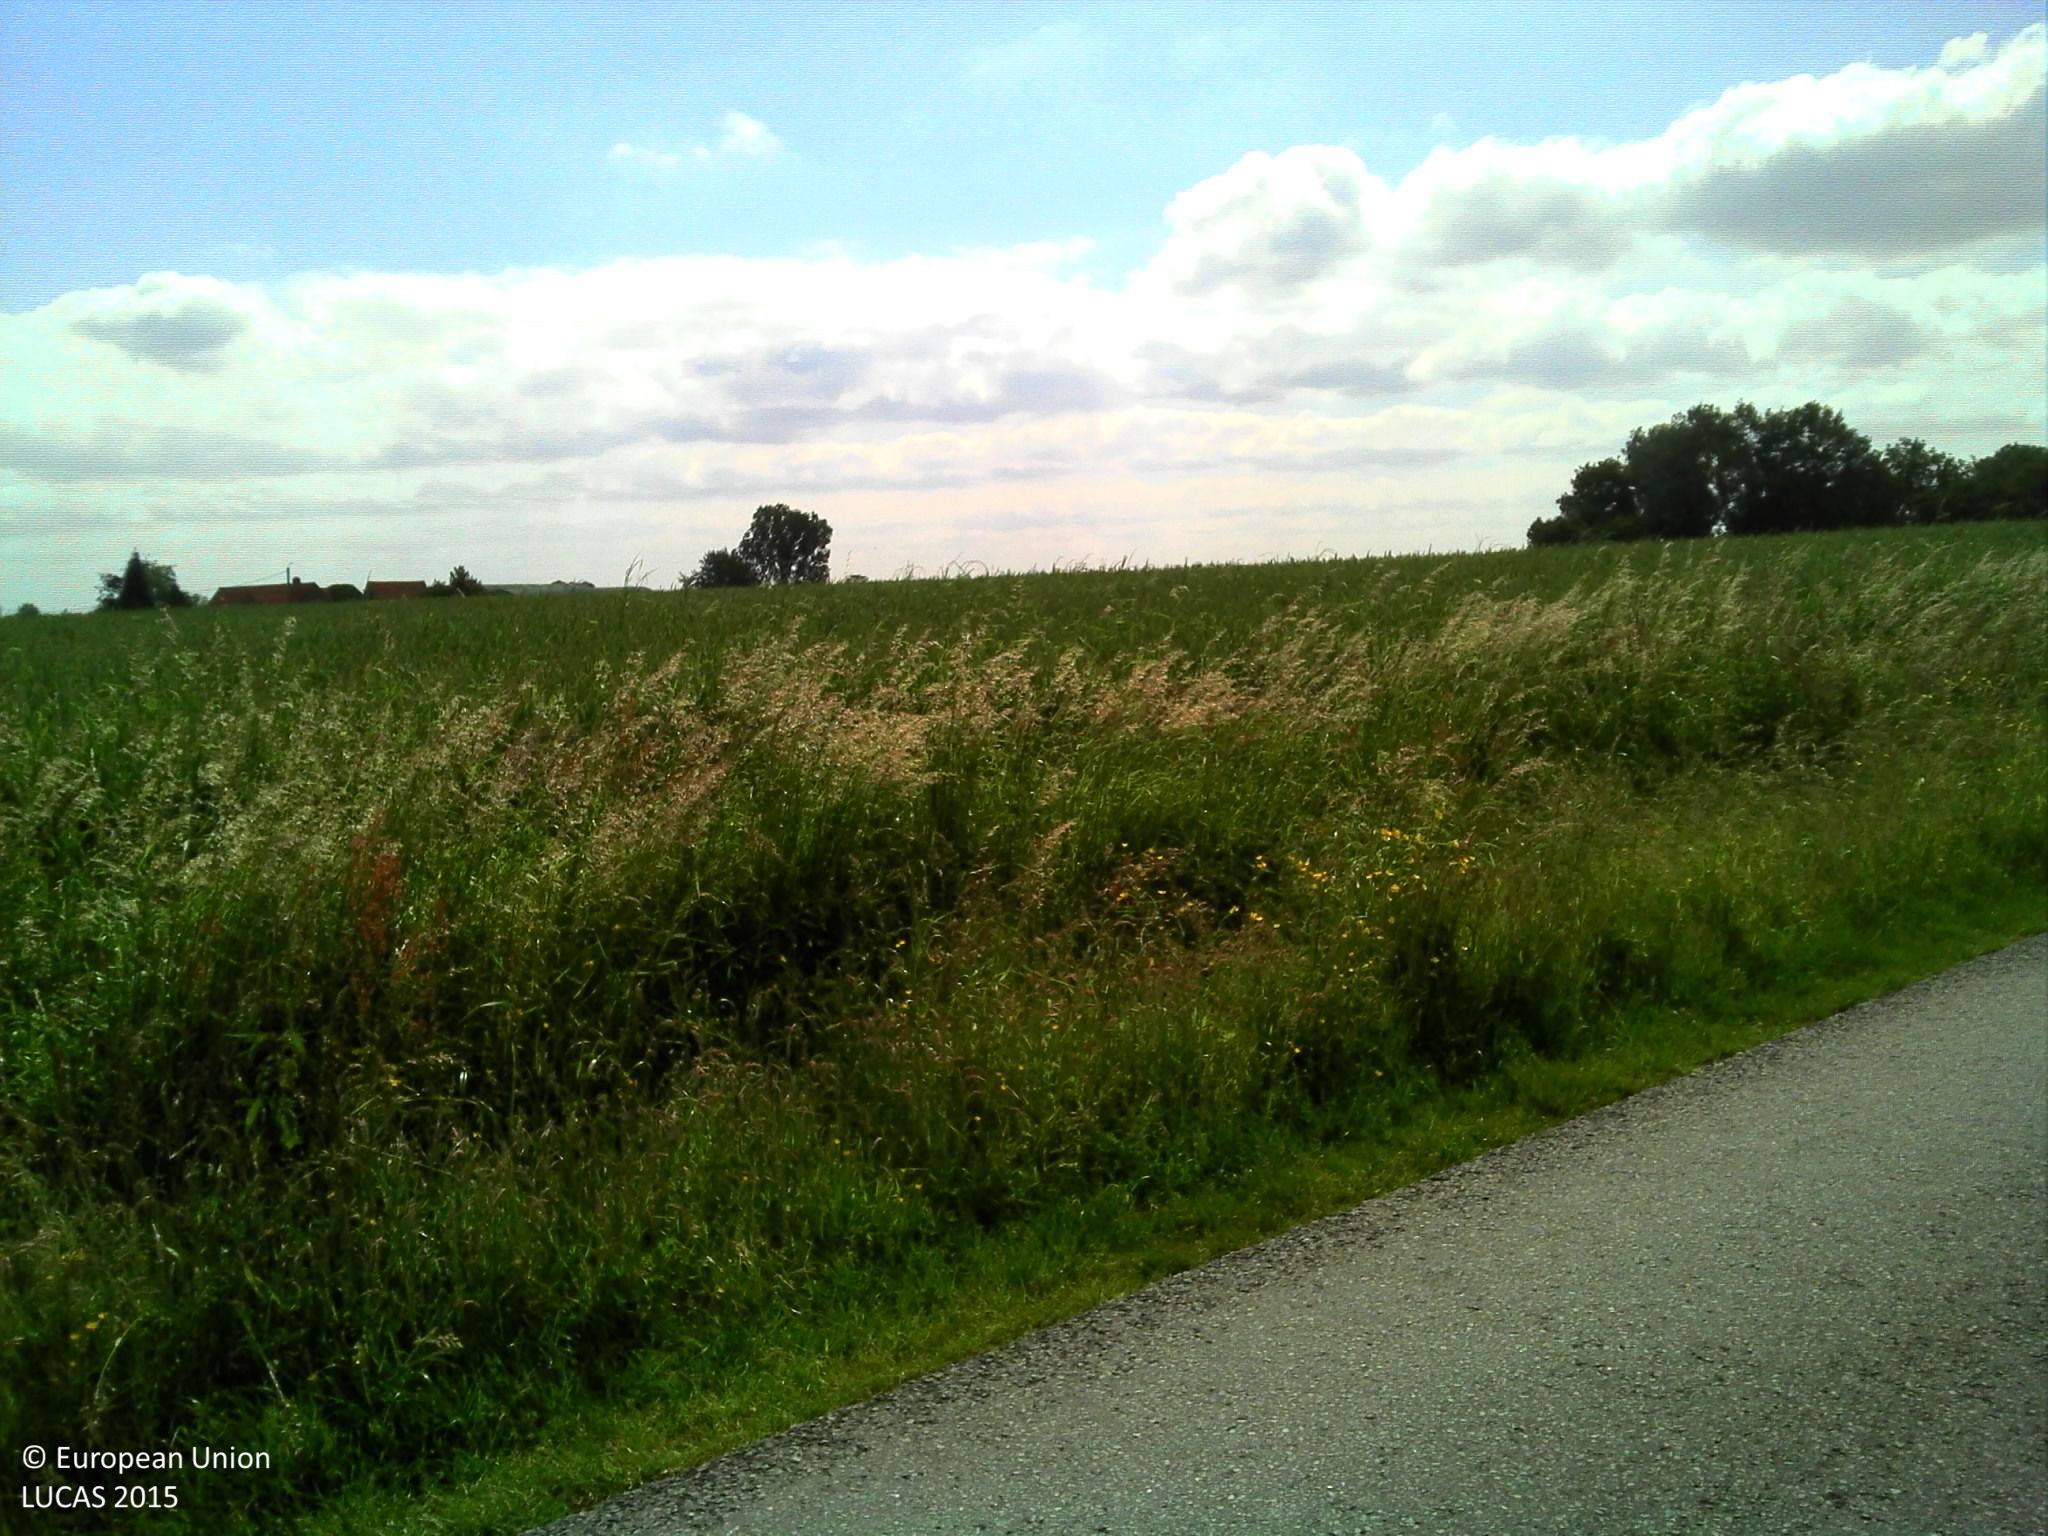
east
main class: Grassland
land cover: Grassland without tree/shrub cover
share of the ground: > 75 %
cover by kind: herbaceous plants 100 %
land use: Agriculture (excluding fallow land and kitchen gardens)
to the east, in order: Grassland without tree/shrub cover; Fences; Grassland without tree/shrub cover; Fences; Grass margins; Ditches and canals; Paved roads, cycling and walking lanes; Ditches and canals; Grass margins; Electric lines; Common wheat
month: June
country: BE
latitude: 50.8416
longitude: 3.1028
